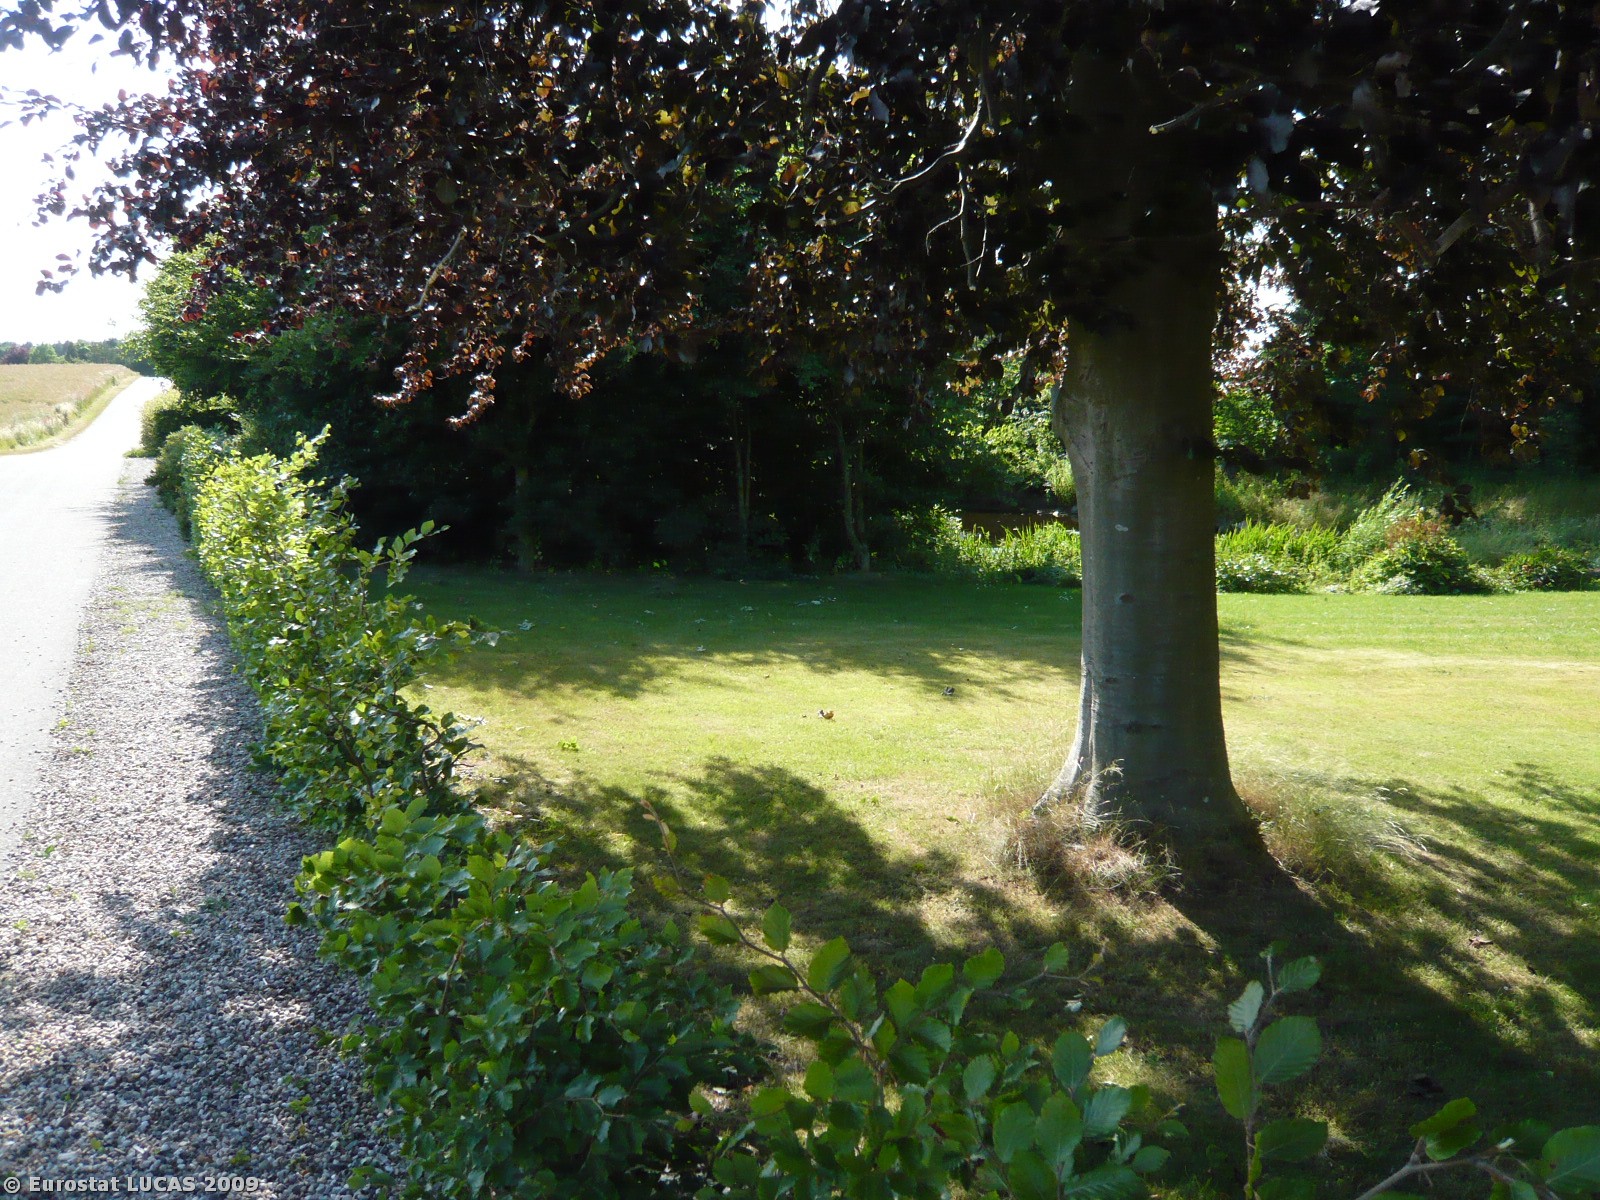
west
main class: Grassland
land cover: Grassland without tree/shrub cover
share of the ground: > 75 %
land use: Residential
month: July
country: DK
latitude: 55.3233
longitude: 10.6456
